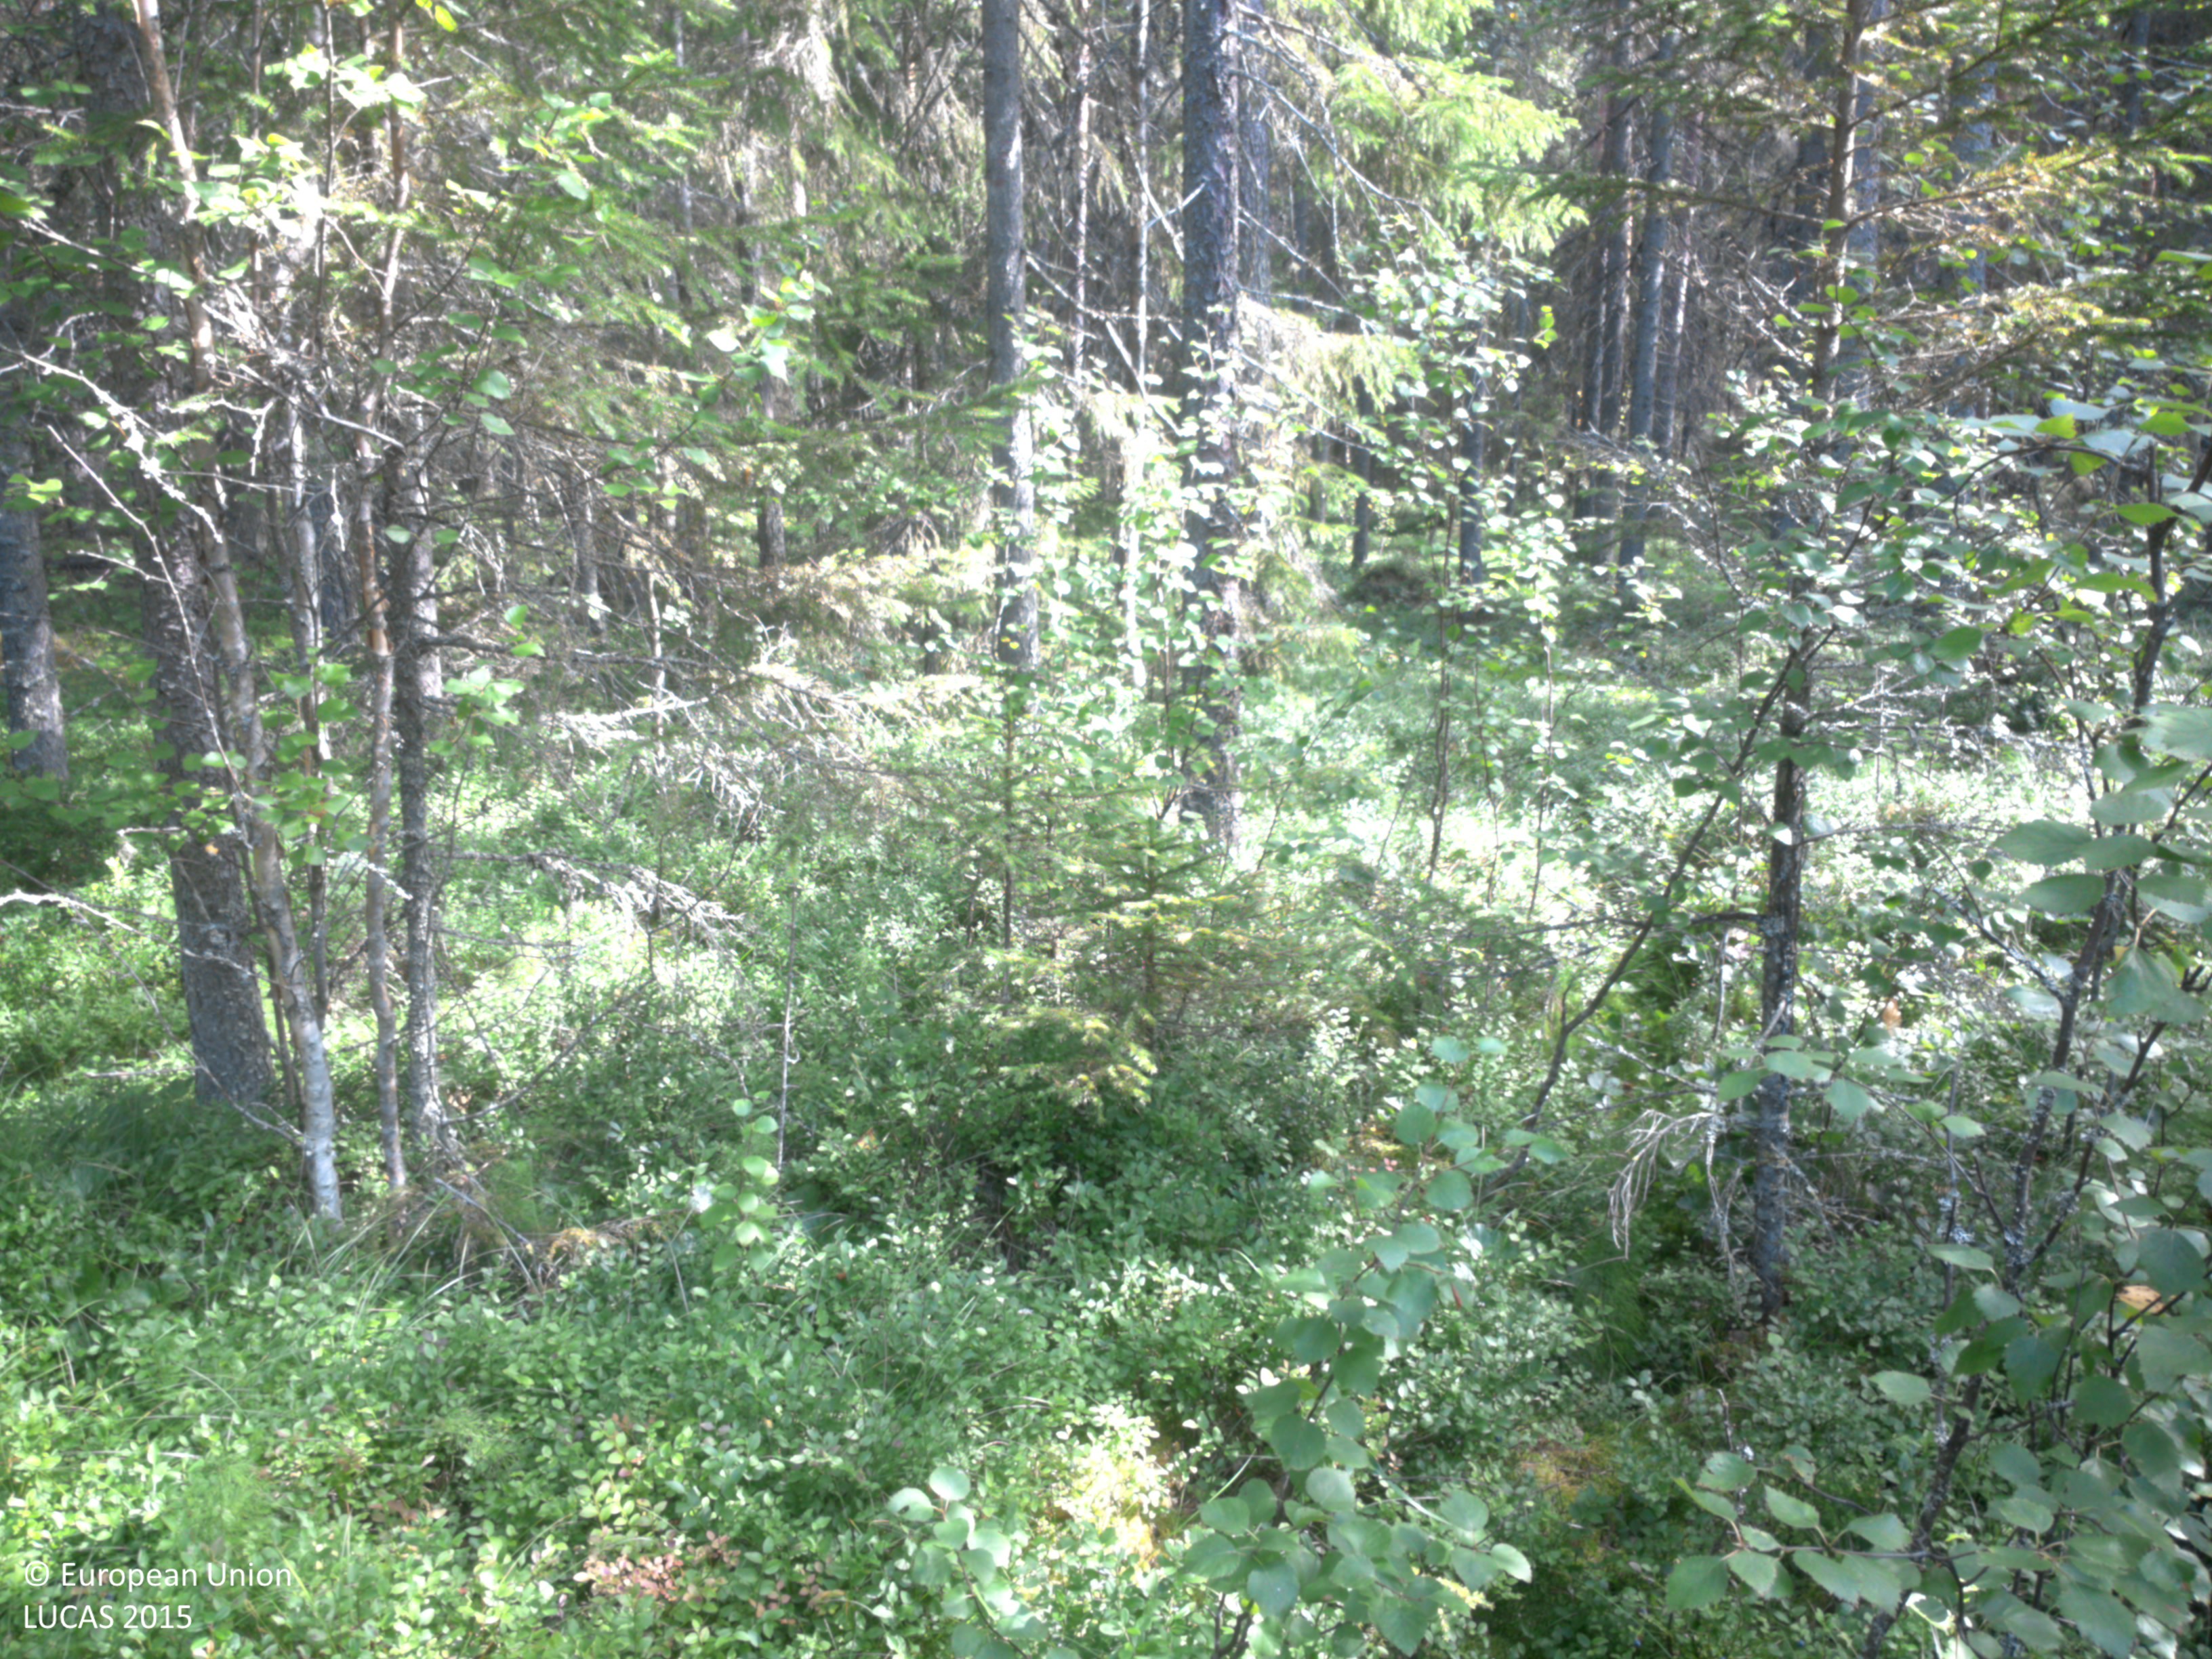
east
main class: Woodland
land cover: Other mixed woodland
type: boreal forest
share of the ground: 50 - 75 %
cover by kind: coniferous forest trees 40 %, shrubs 35 %, broadleaved forest trees 25 %
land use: Forestry
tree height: > 5 m
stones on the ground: < 10 %
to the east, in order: Other mixed woodland; Ditches and canals; Other mixed woodland; Ditches and canals; Other mixed woodland; Pine dominated mixed woodland; Other coniferous woodland; Spruce dominated mixed woodland
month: August
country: SE
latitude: 63.5844
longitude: 19.5091
